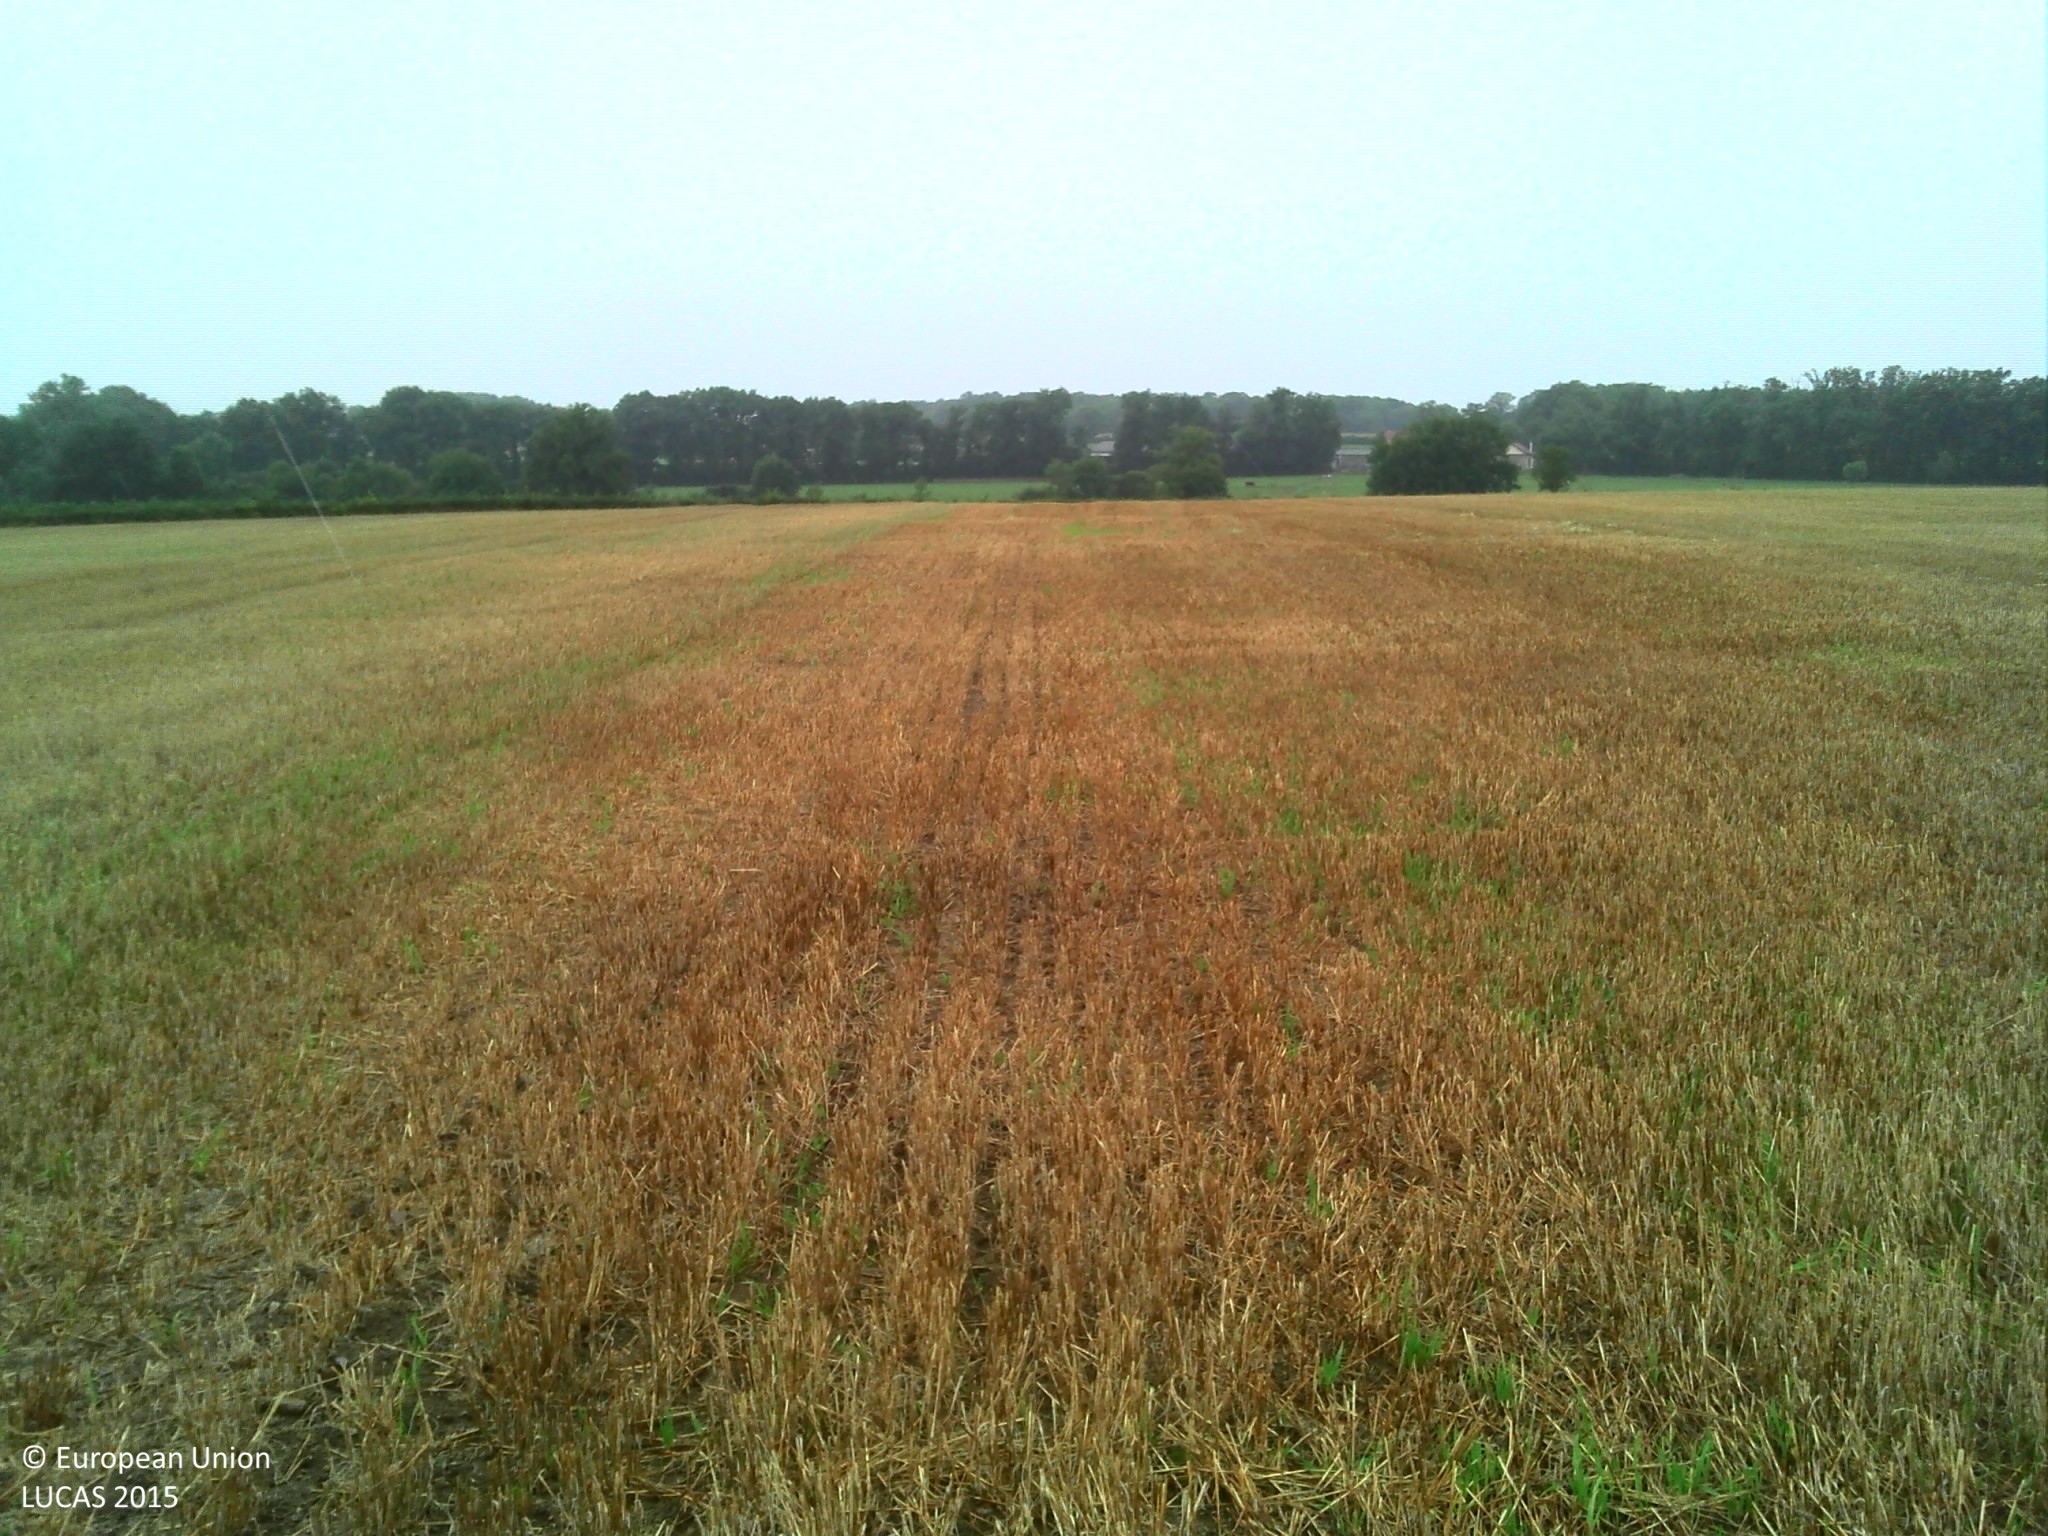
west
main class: Cropland
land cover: Barley
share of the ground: 50 - 75 %
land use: Agriculture (excluding fallow land and kitchen gardens)
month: August
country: FR
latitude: 46.2403
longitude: 2.3567
